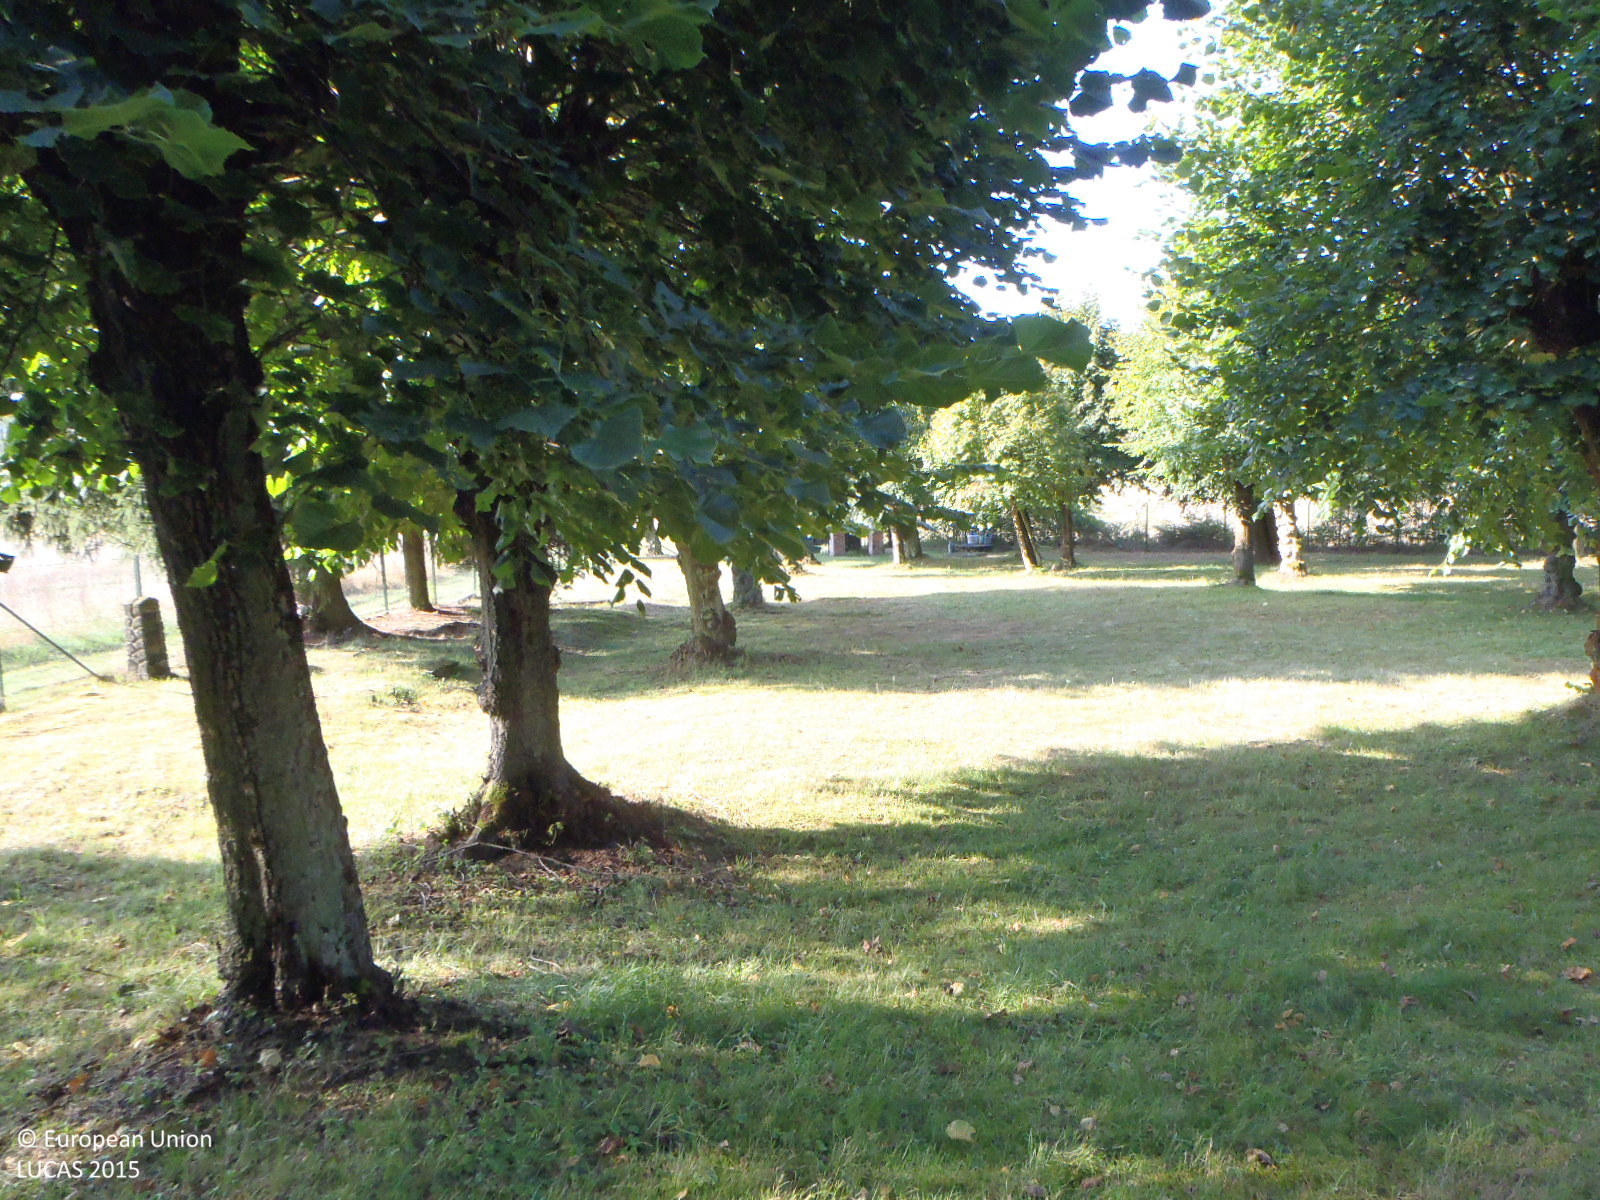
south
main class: Woodland
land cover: Broadleaved woodland
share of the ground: 25 - 50 %
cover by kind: herbaceous plants 60 %, broadleaved forest trees 40 %
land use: Community services
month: August
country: CZ
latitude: 50.7586
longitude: 14.5809
